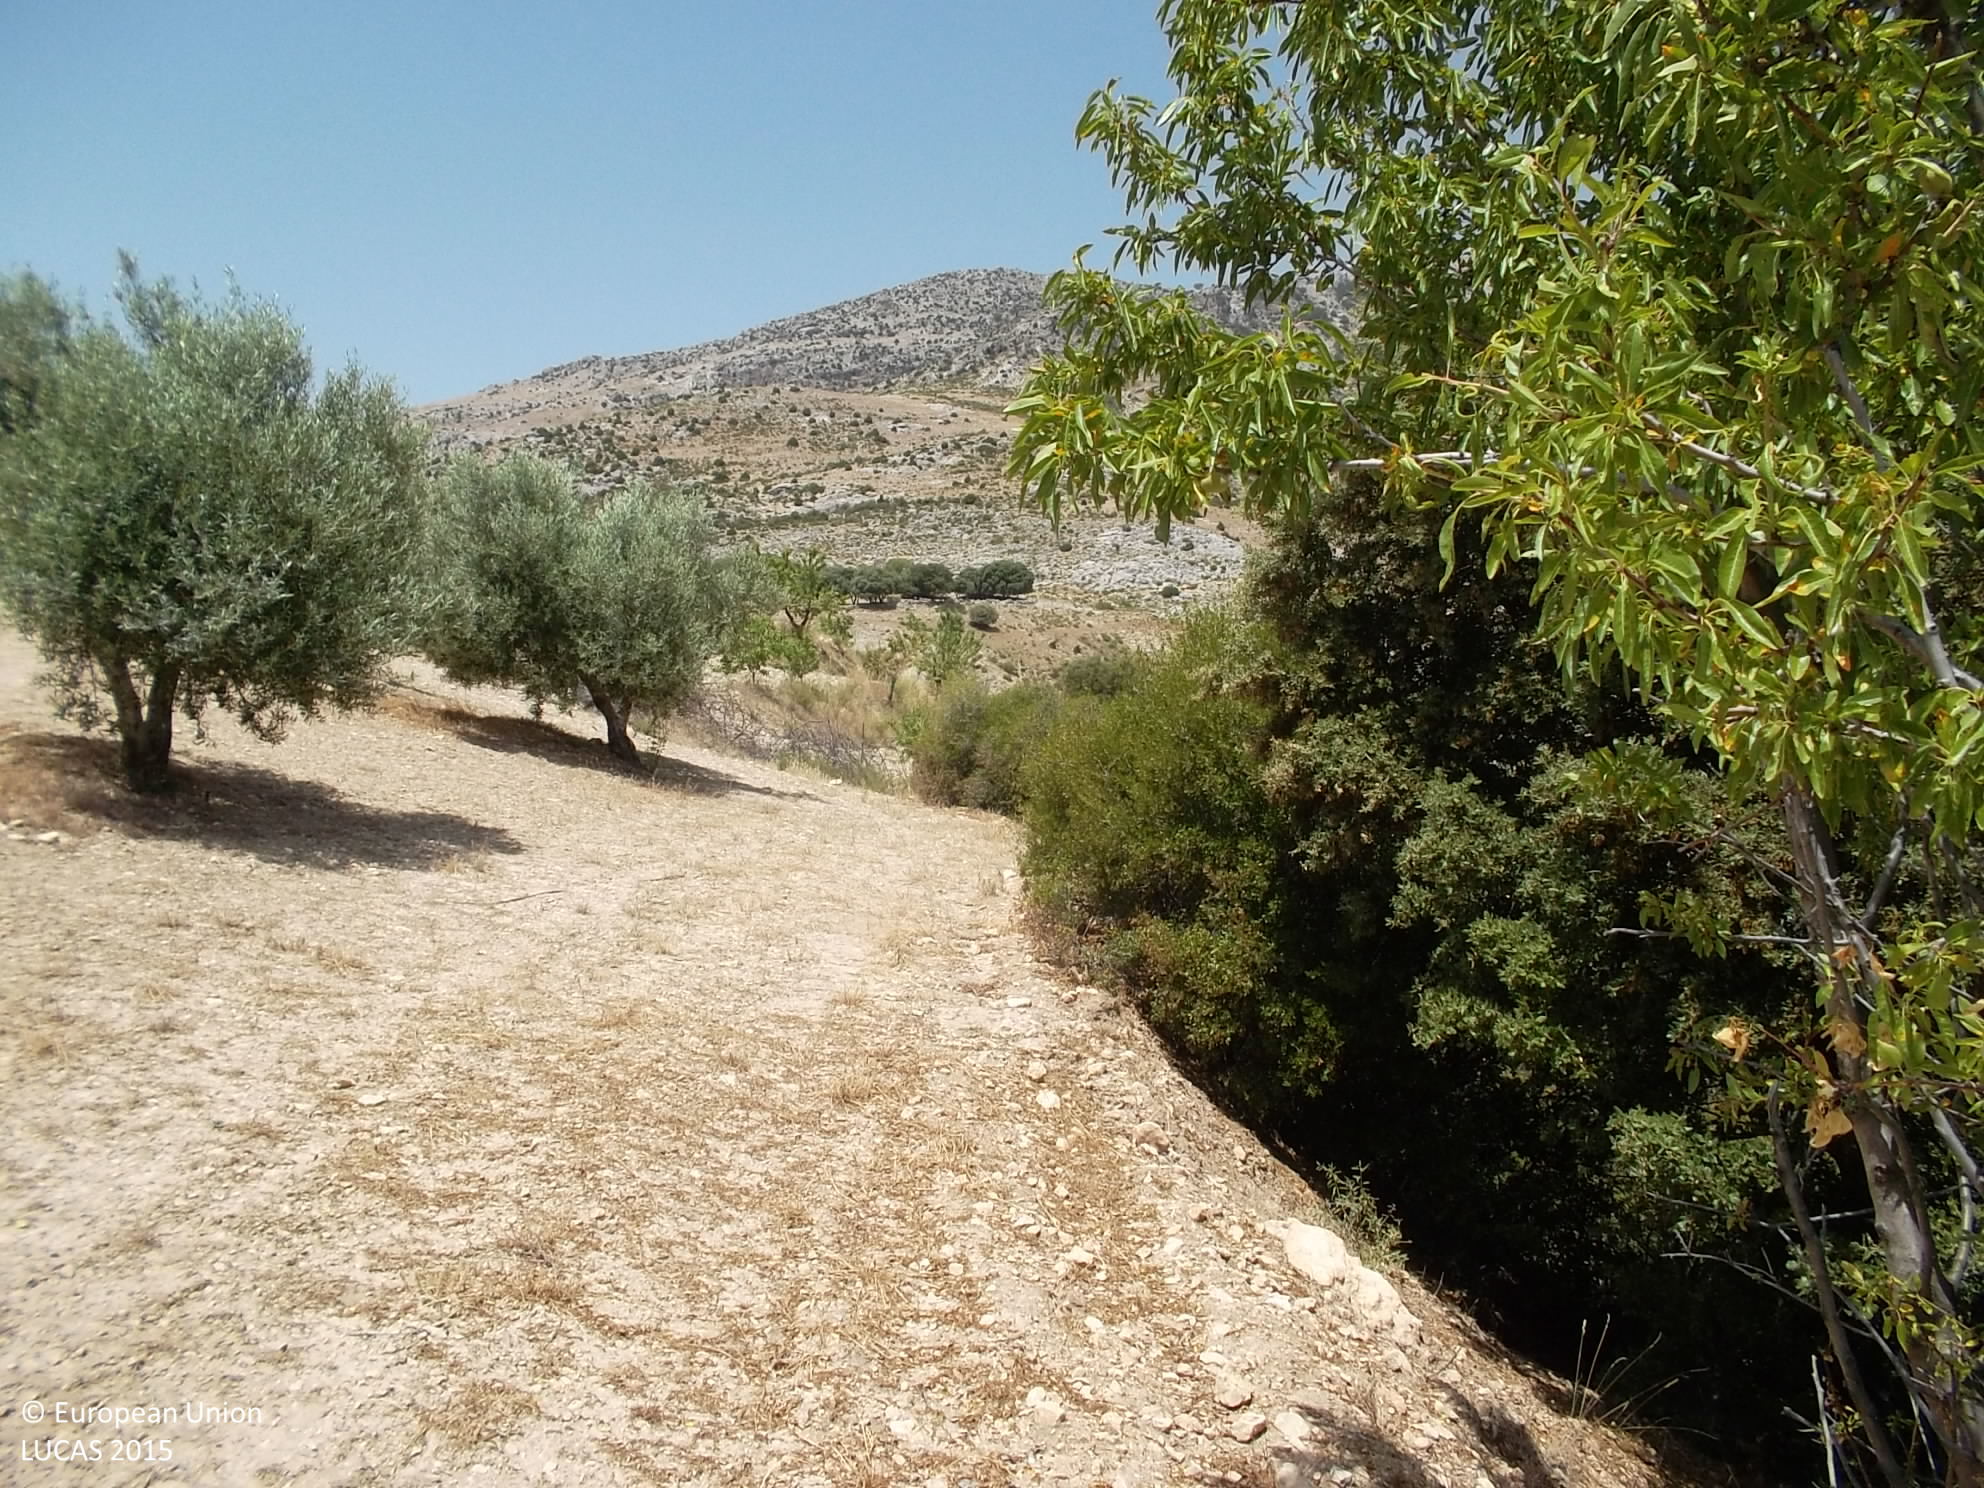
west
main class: Woodland
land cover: Broadleaved woodland
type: broadleaved evergreen forest
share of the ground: 10 - 25 %
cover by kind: broadleaved forest trees 40 %, unconsolidated bare surface 30 %, coniferous forest trees 10 %, shrubs 10 %, herbaceous plants 10 %
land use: Forestry
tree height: > 5 m
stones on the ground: 10 - 25 %
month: July
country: ES
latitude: 37.8115
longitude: -2.8163
